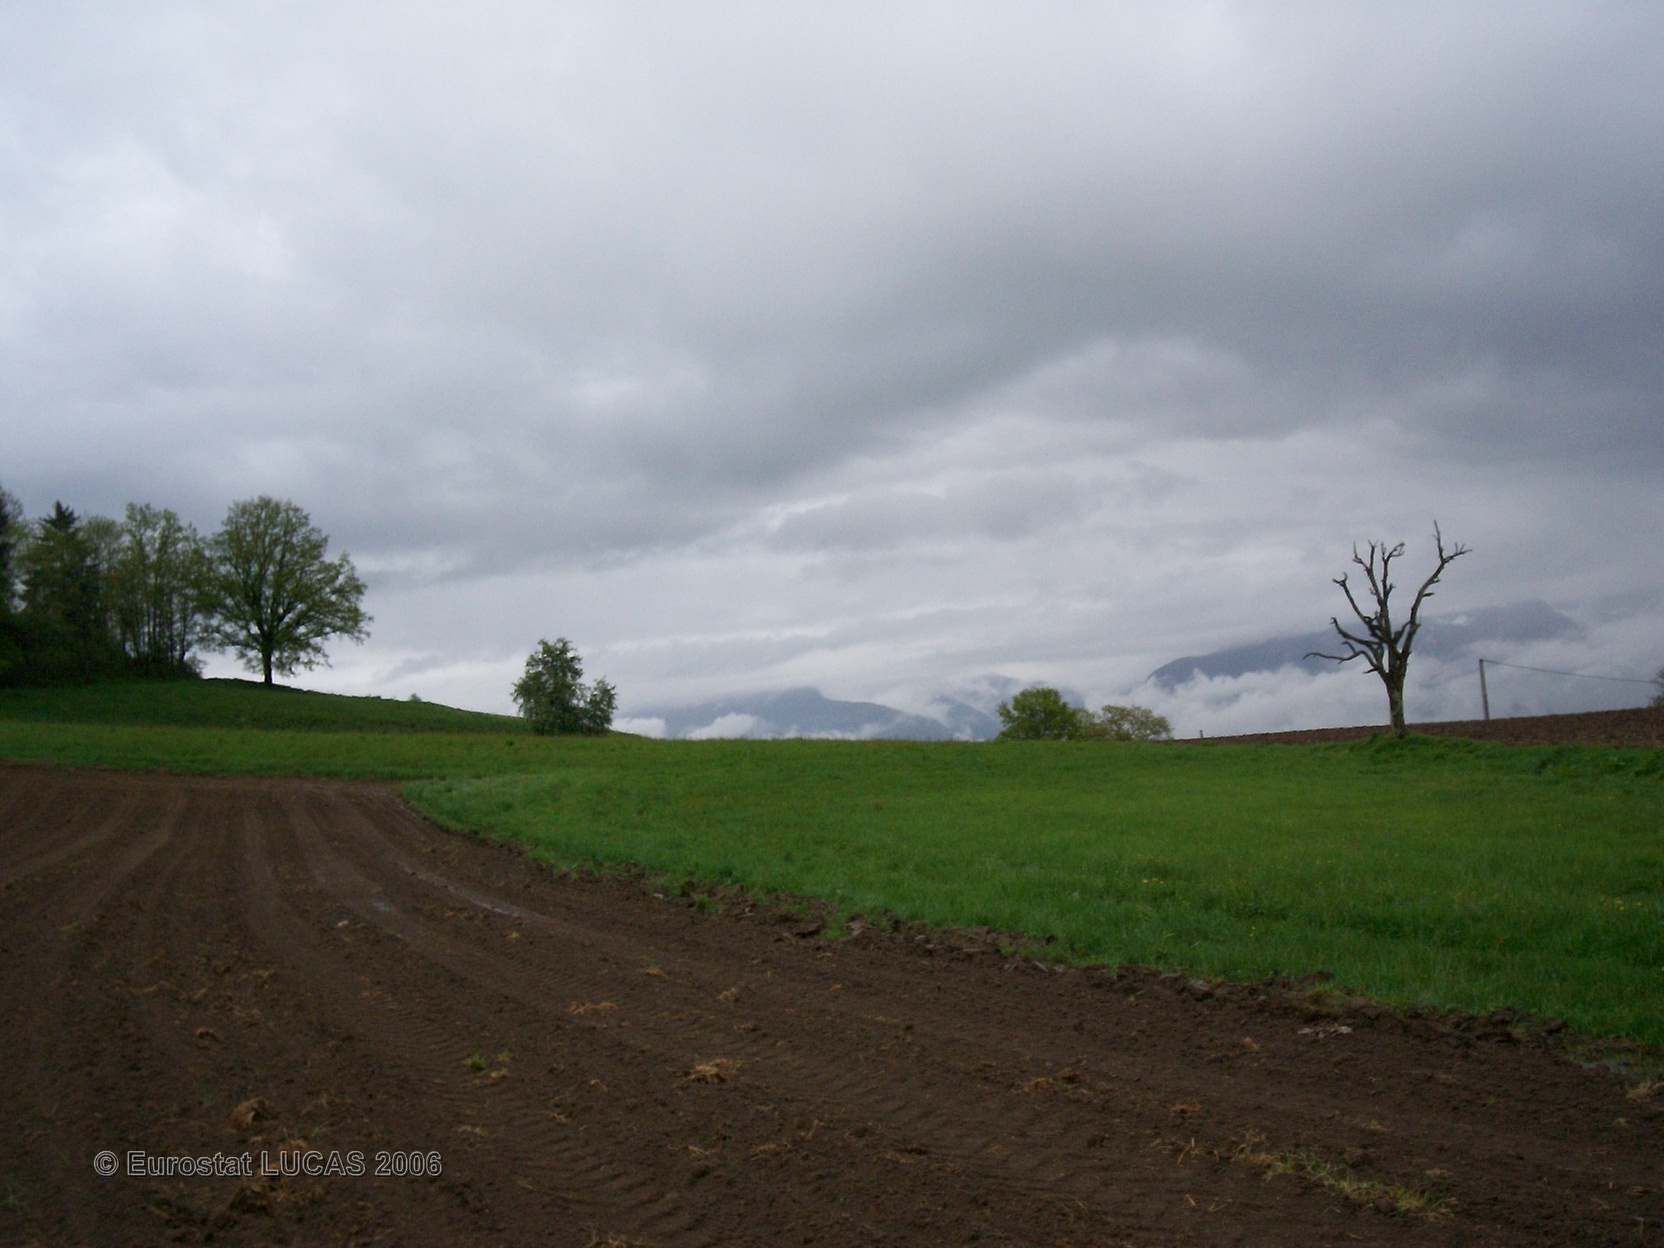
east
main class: Cropland
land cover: Maize
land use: Agriculture (excluding fallow land and kitchen gardens)
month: May
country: FR
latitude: 46.0282
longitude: 6.1151
